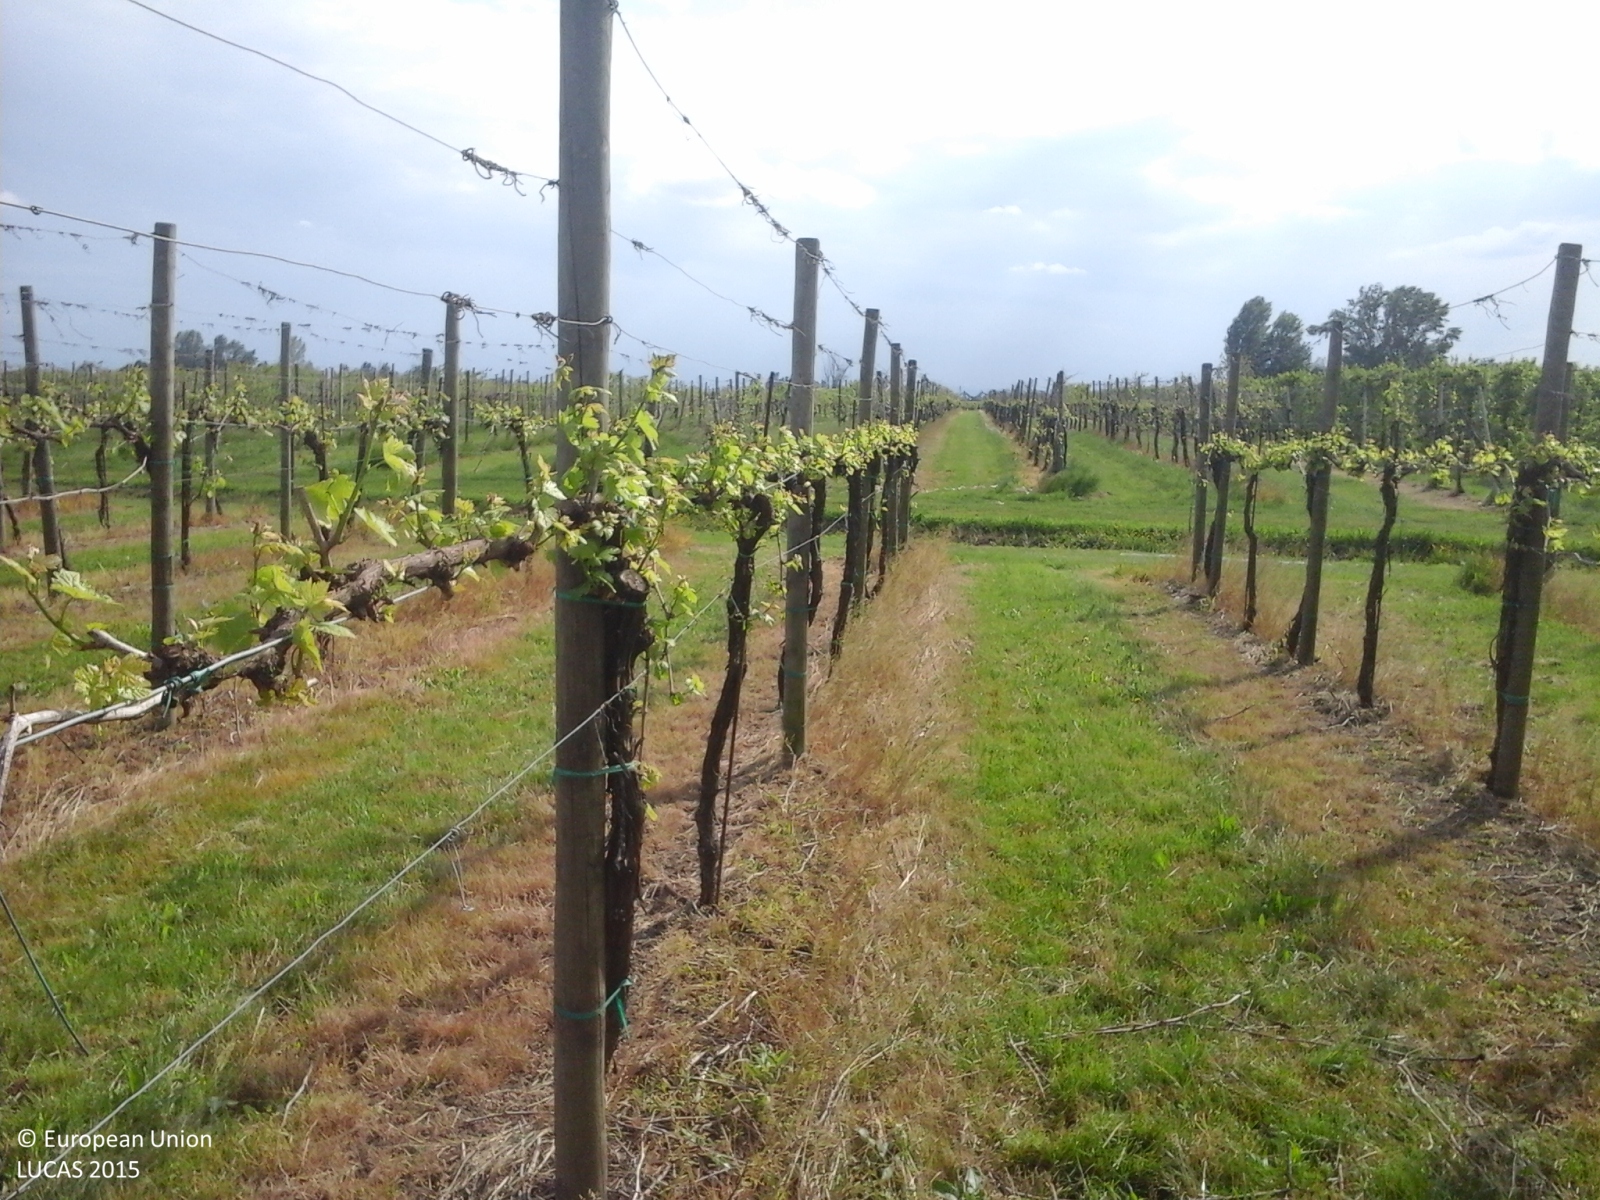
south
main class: Cropland
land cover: Vineyards
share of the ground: 10 - 25 %
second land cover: Grassland without tree/shrub cover
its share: > 75 %
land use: Agriculture (excluding fallow land and kitchen gardens)
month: April
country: IT
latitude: 44.8705
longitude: 10.7958
